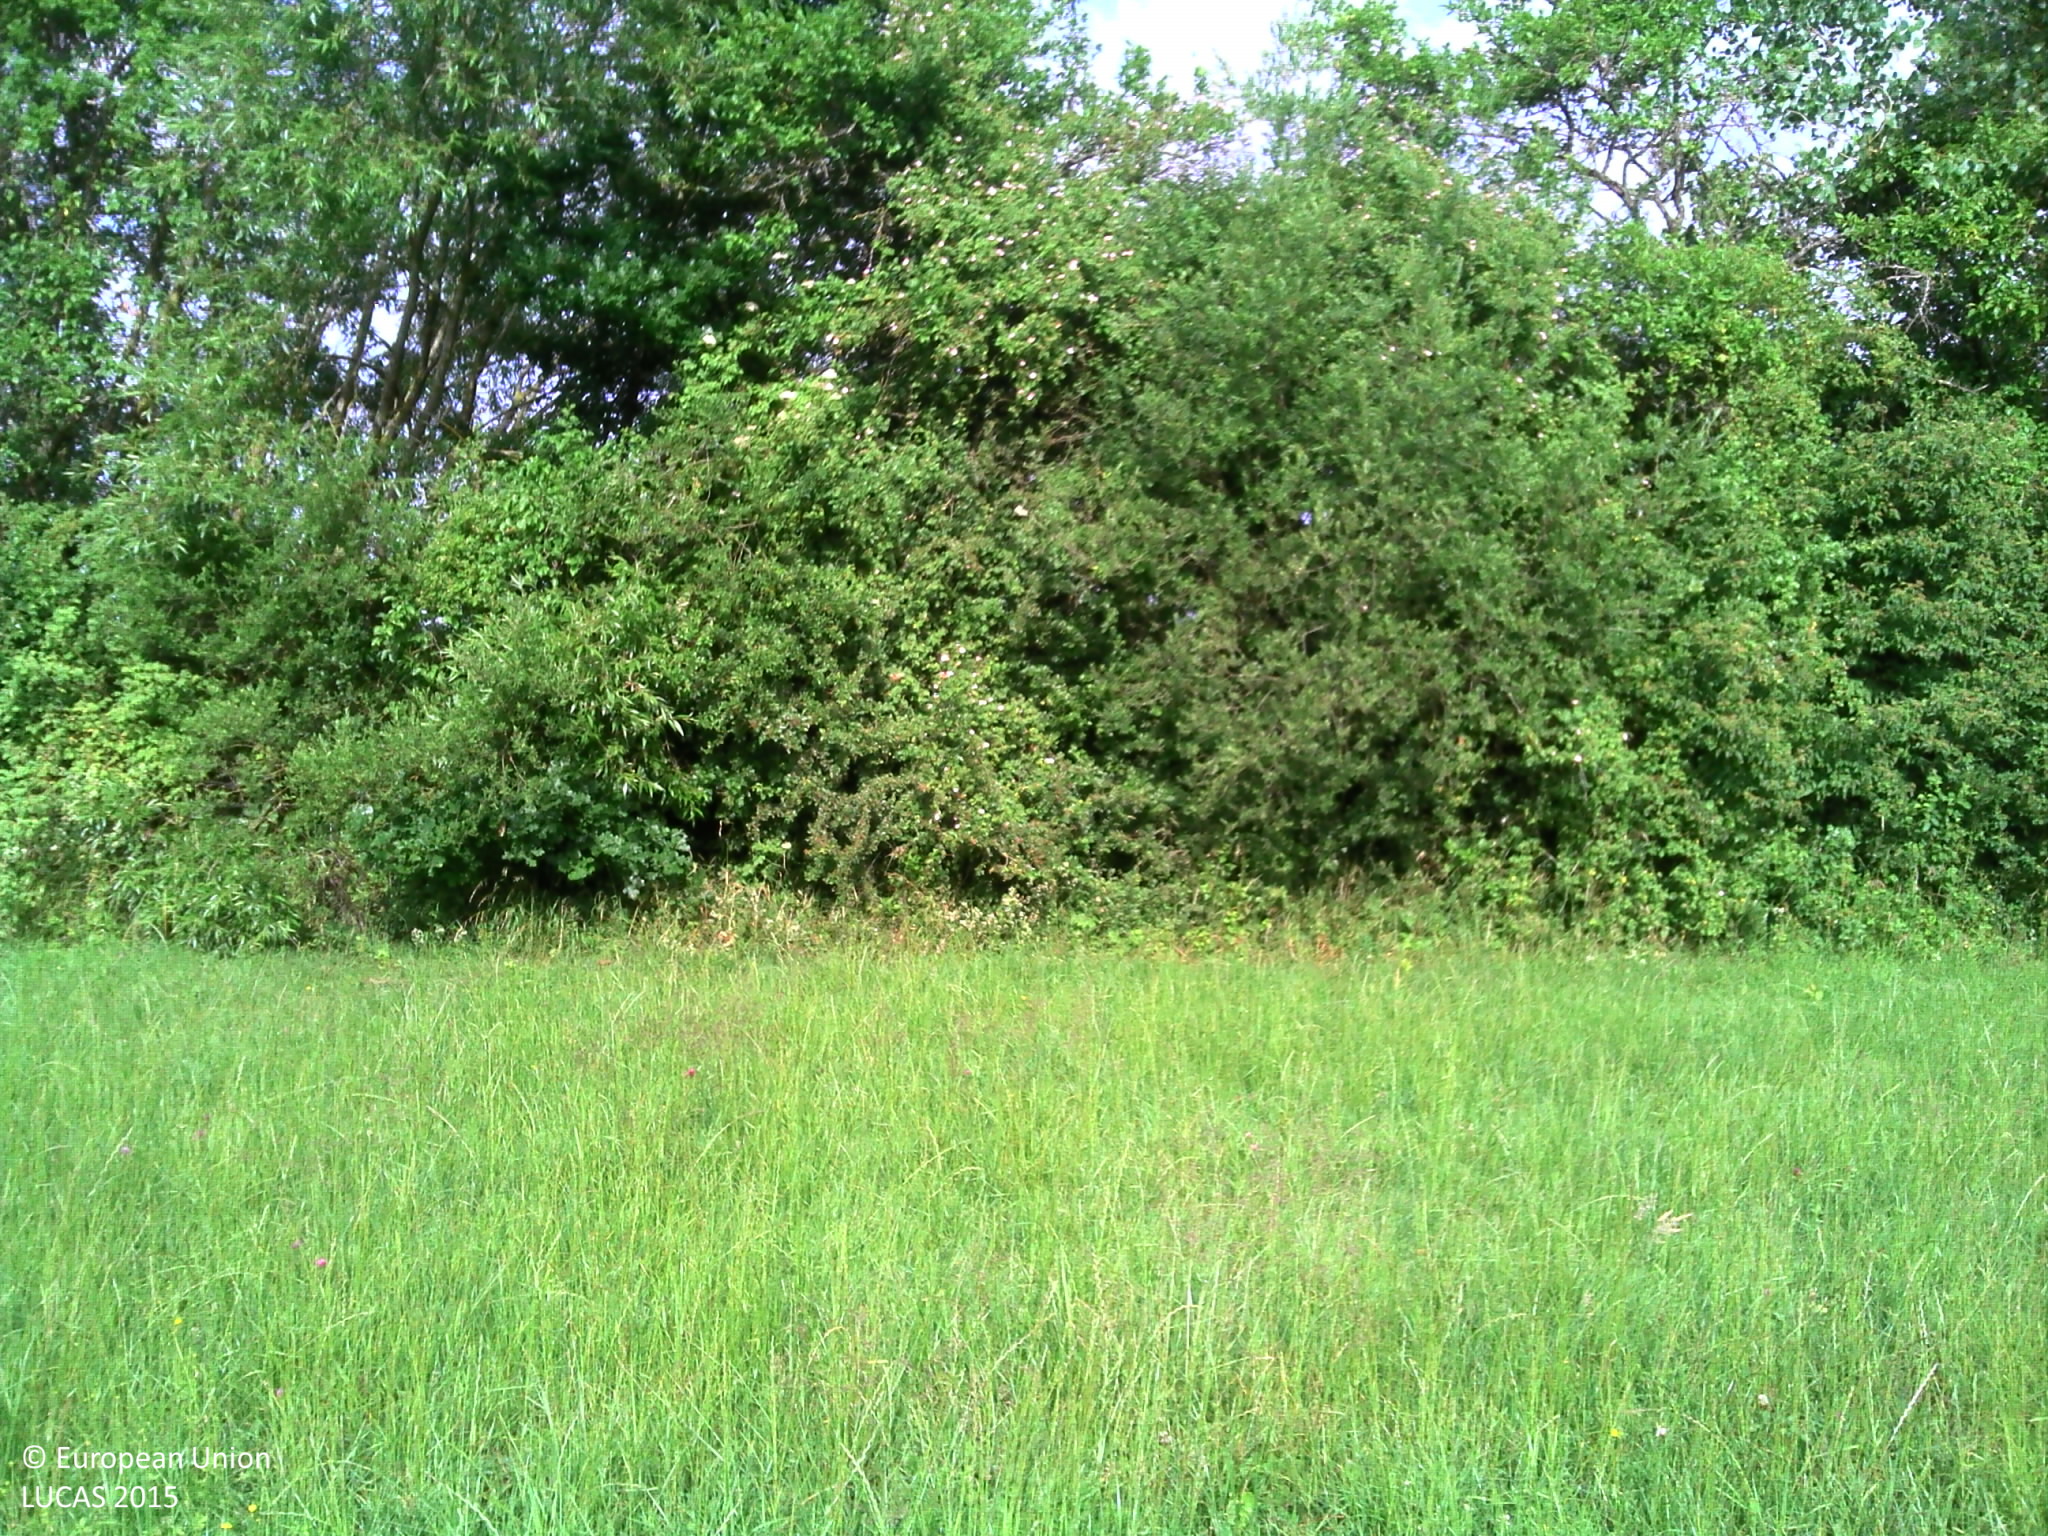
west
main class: Grassland
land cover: Grassland without tree/shrub cover
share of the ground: > 75 %
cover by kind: herbaceous plants 100 %
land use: Agriculture (excluding fallow land and kitchen gardens)
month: June
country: LU
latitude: 49.7487
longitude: 6.3773
